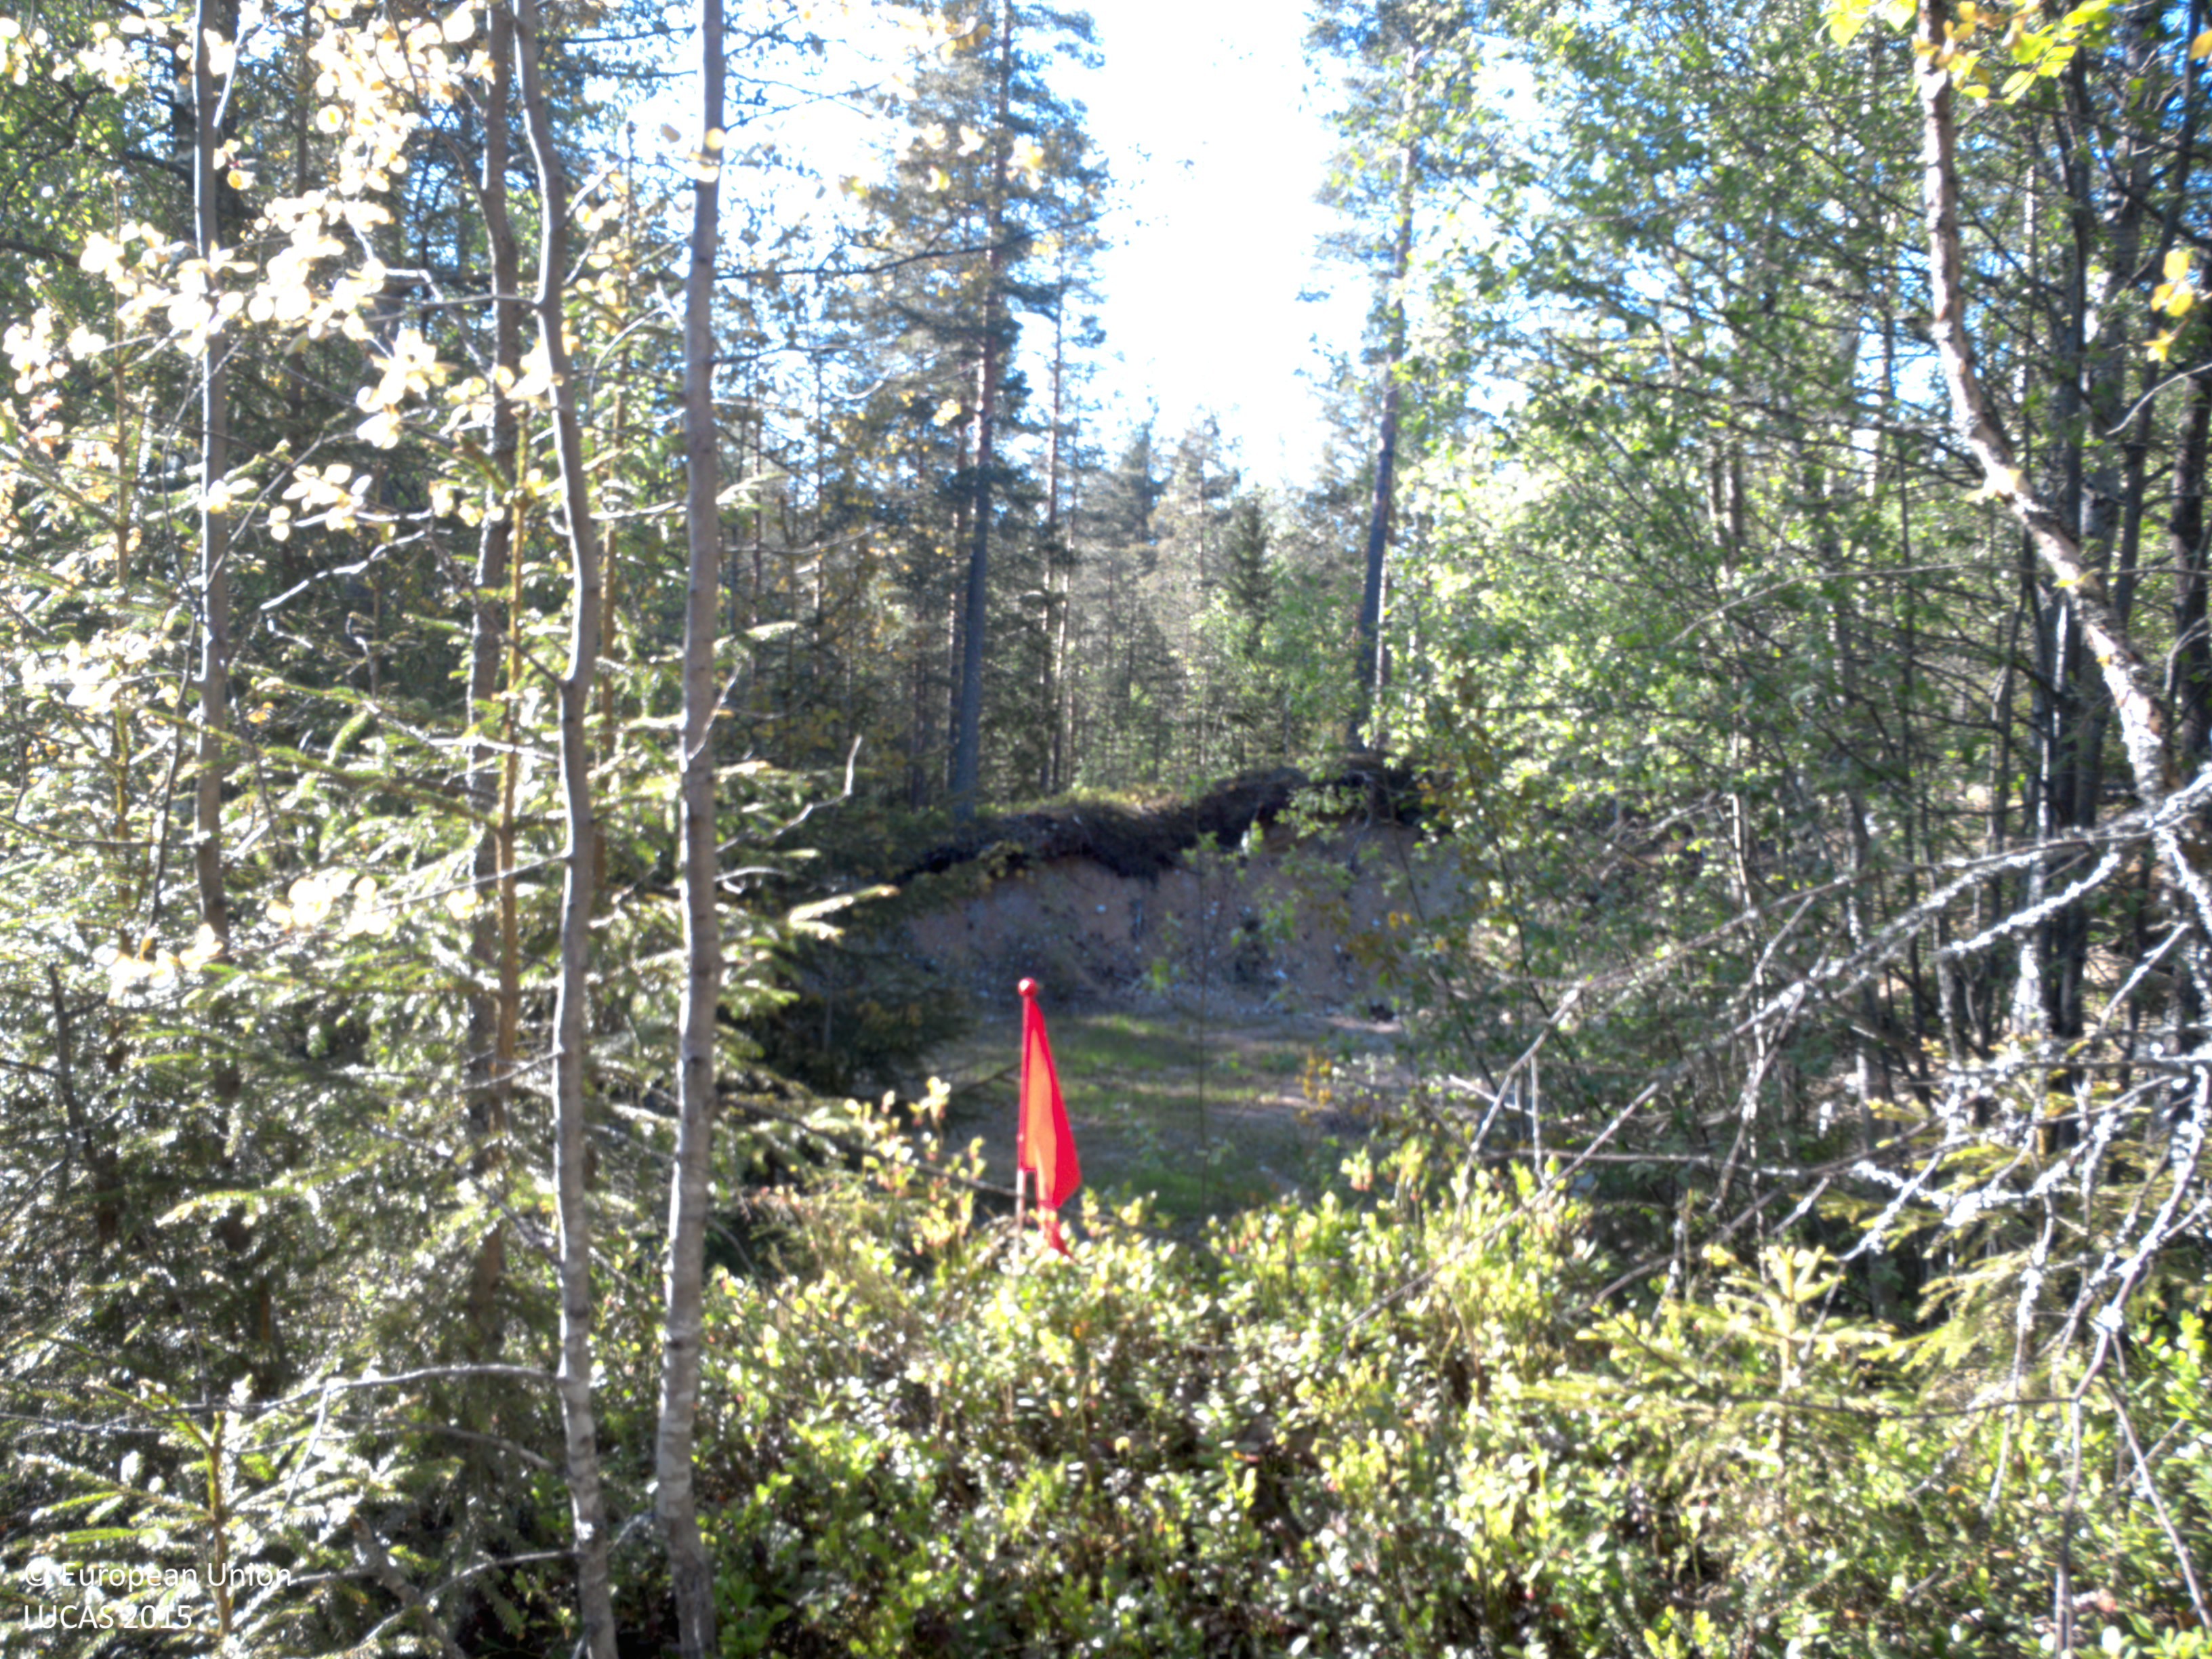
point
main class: Woodland
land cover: Other mixed woodland
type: boreal forest
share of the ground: 50 - 75 %
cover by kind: shrubs 45 %, coniferous forest trees 30 %, broadleaved forest trees 25 %
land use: Semi-natural and natural areas not in use
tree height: > 5 m
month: June
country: SE
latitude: 63.9847
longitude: 20.0945
